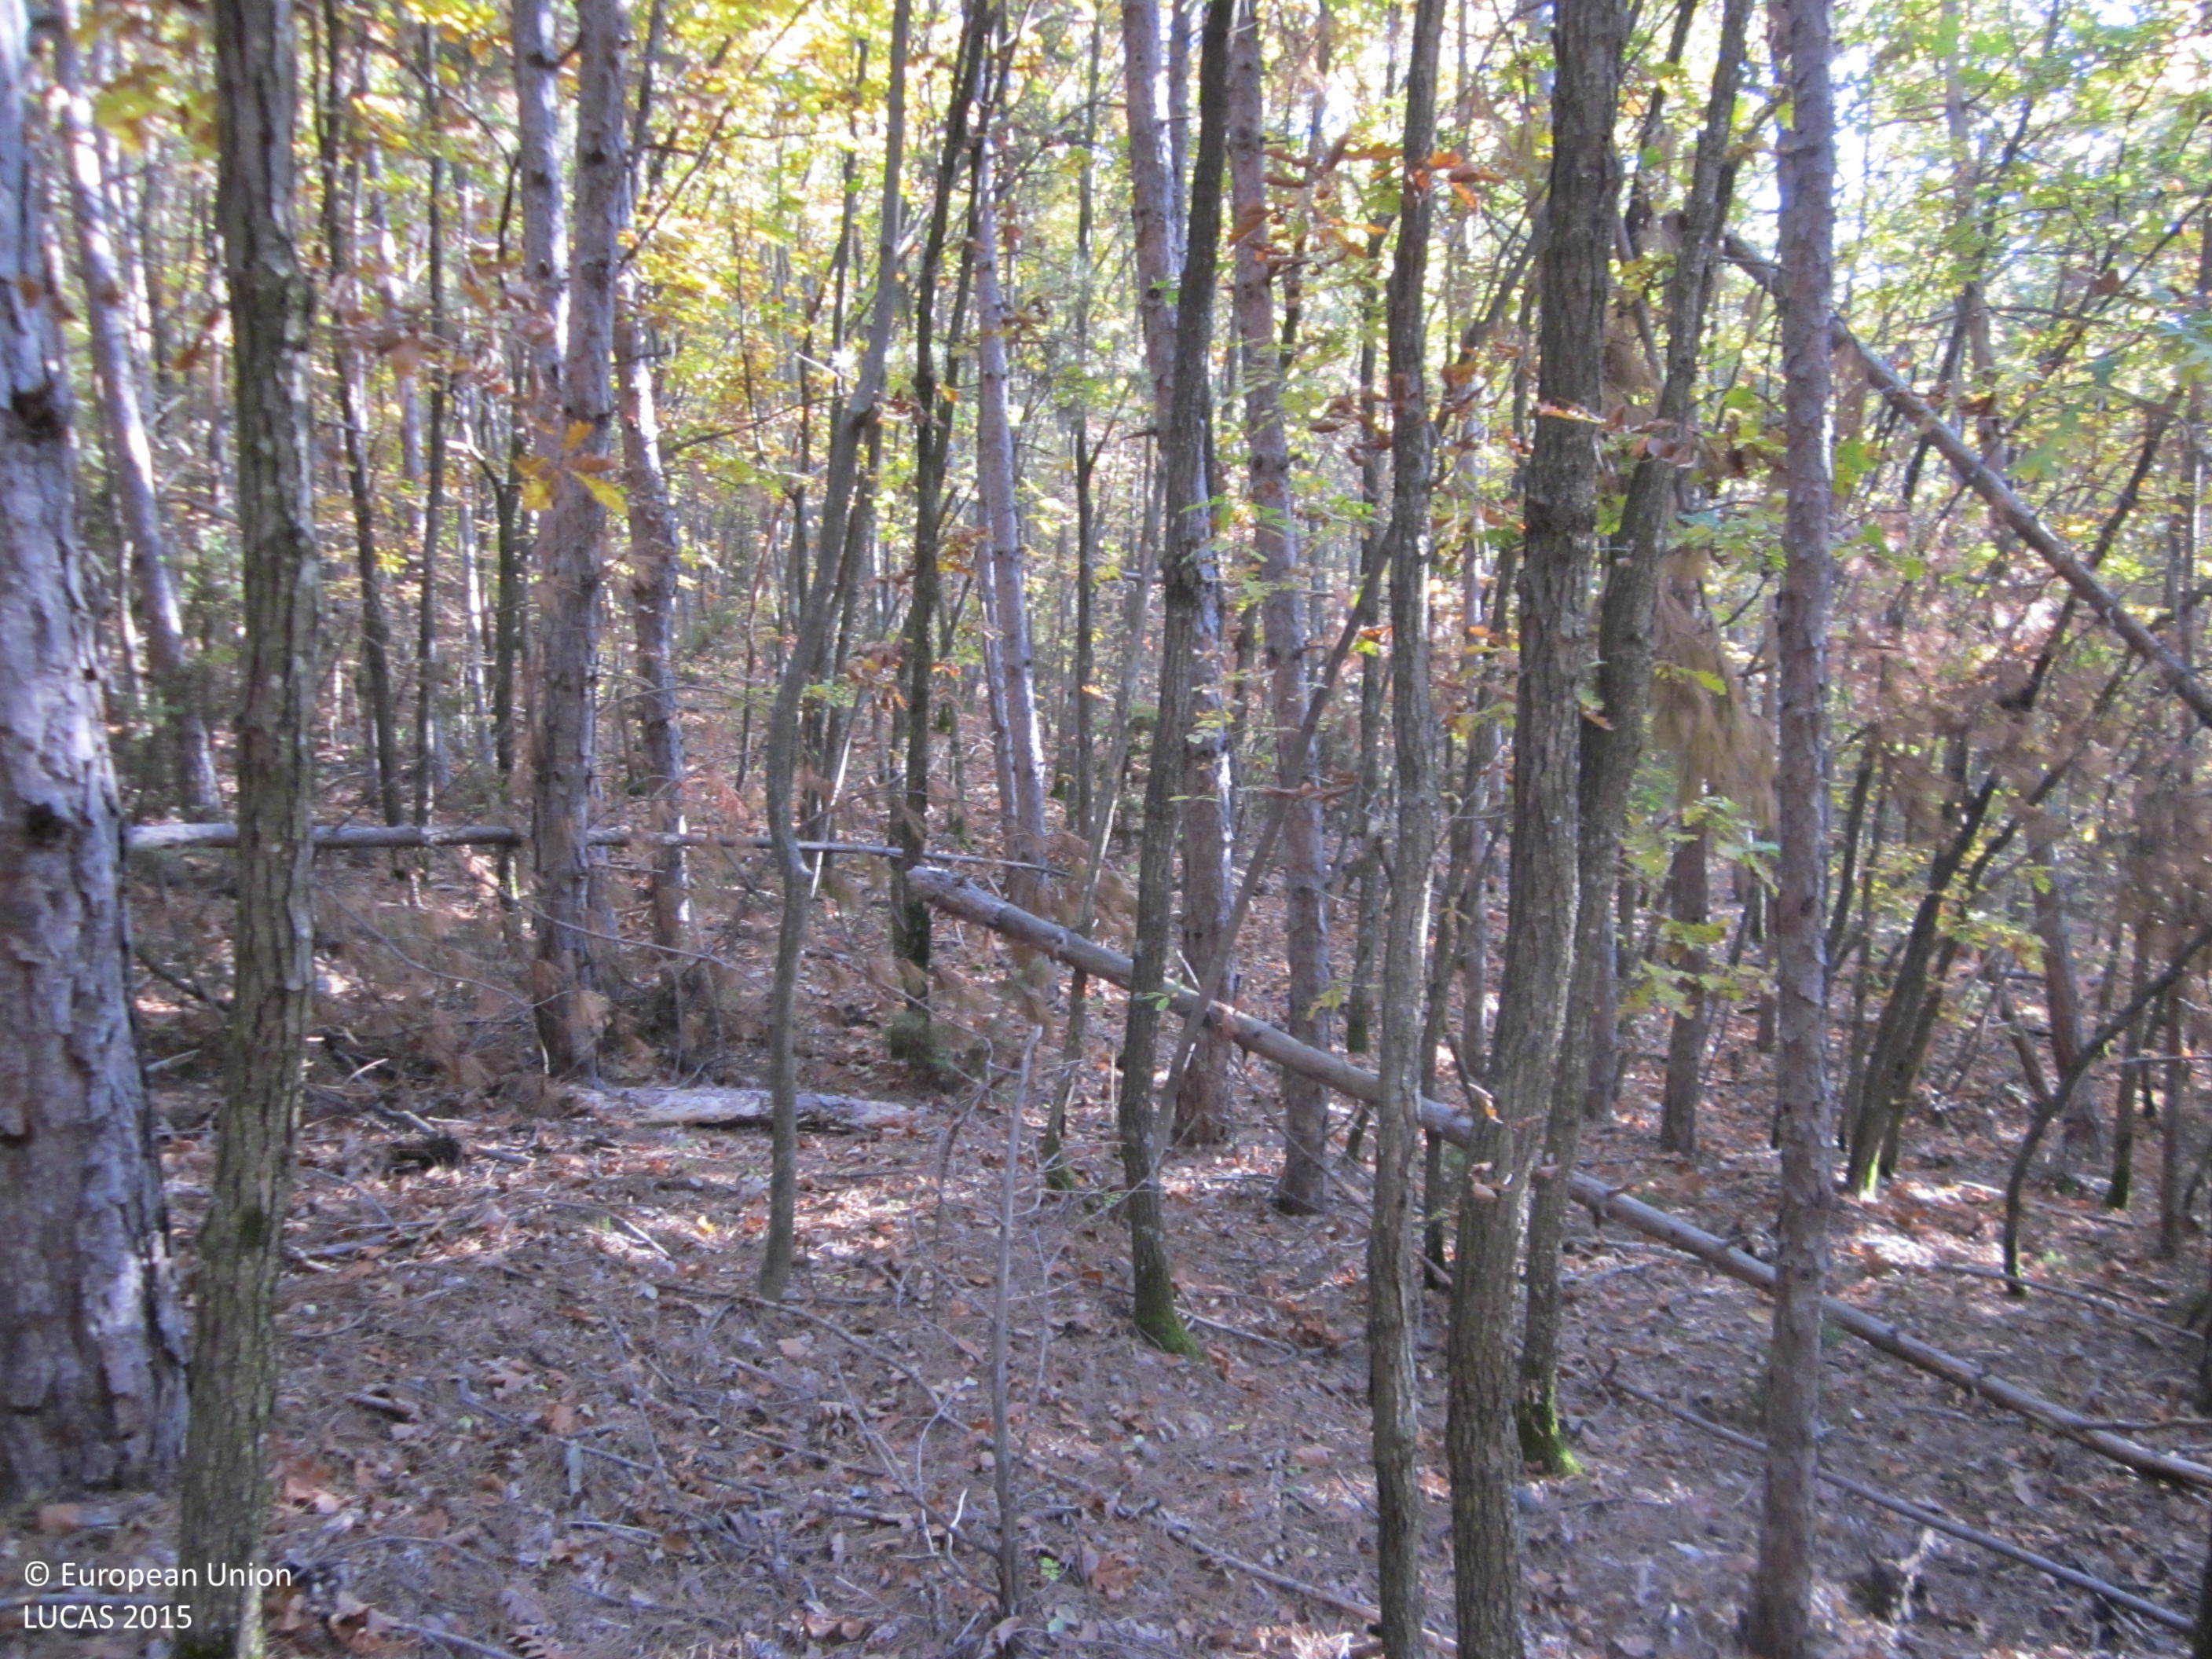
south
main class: Woodland
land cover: Pine dominated mixed woodland
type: hemiboreal forest and nemoral coniferous forest and mixed broadleaved-coniferous forest
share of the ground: > 75 %
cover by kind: coniferous forest trees 60 %, broadleaved forest trees 20 %, unconsolidated bare surface 15 %, lichens and mosses 5 %
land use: Forestry
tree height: > 5 m
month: November
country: BG
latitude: 41.5621
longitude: 25.7352
